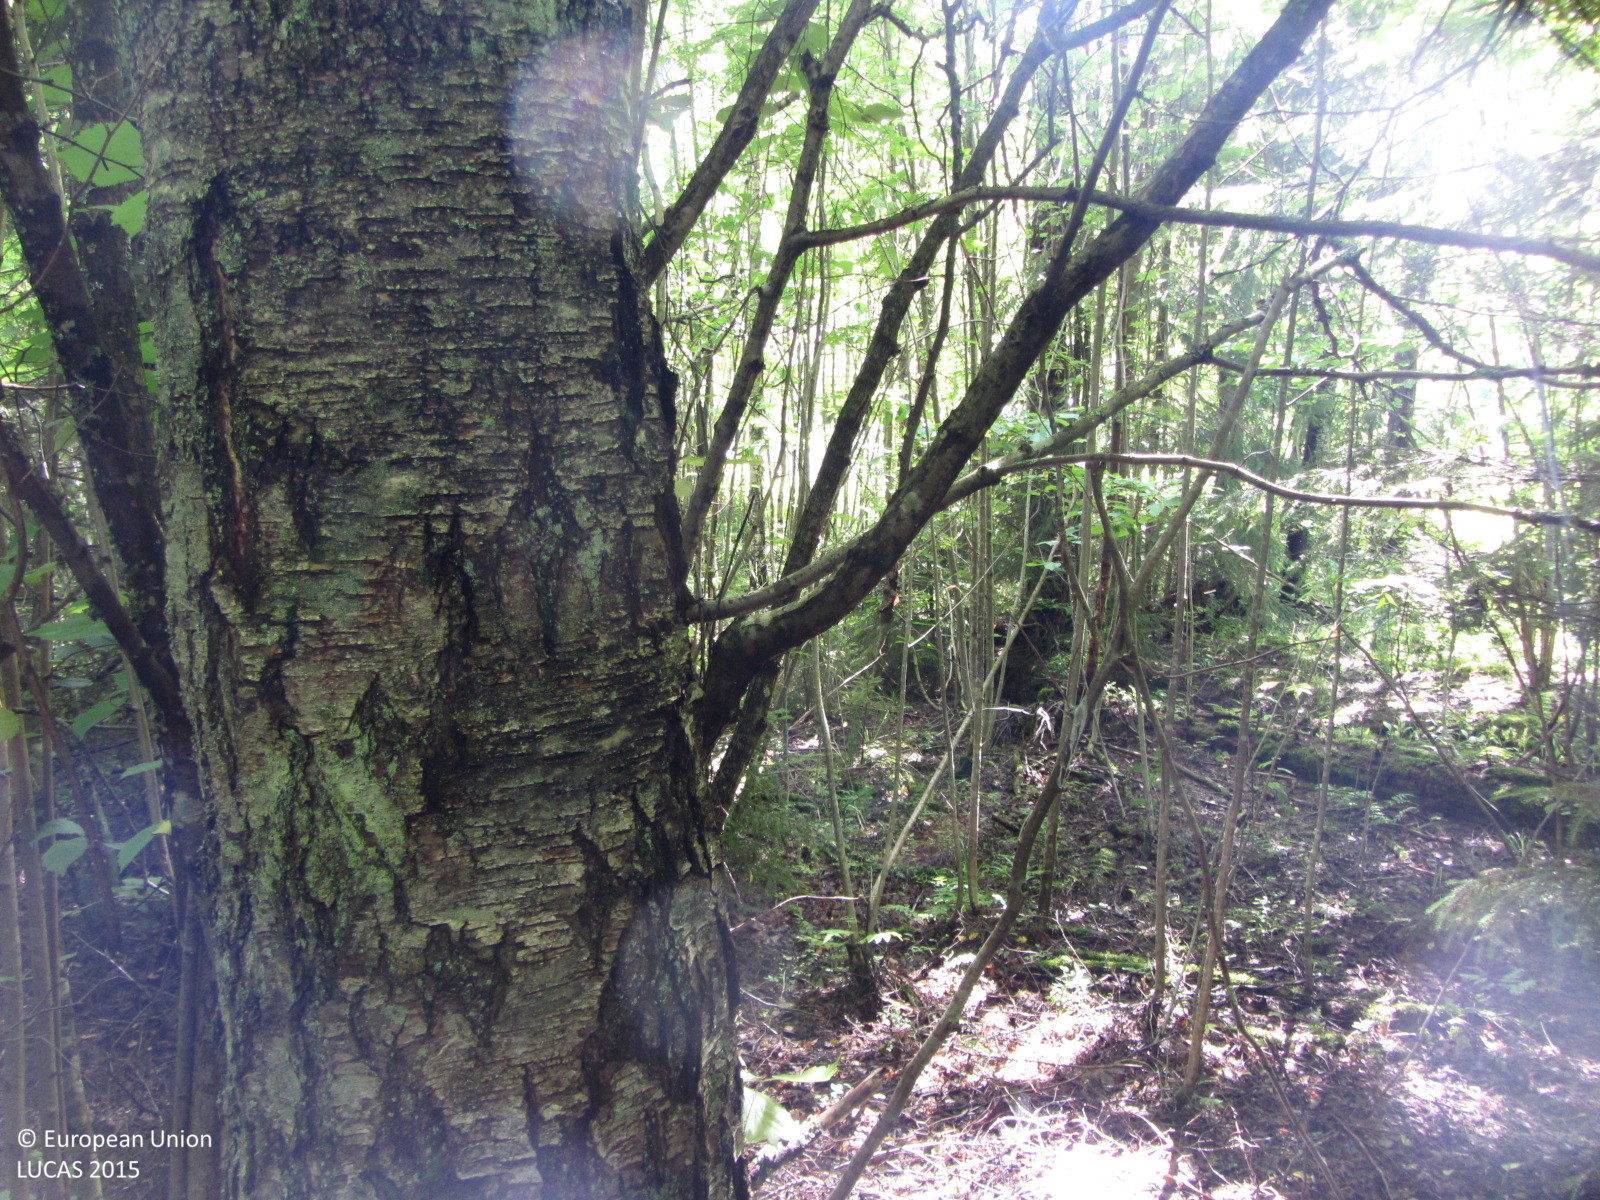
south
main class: Woodland
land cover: Spruce dominated mixed woodland
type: hemiboreal forest and nemoral coniferous forest and mixed broadleaved-coniferous forest
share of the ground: > 75 %
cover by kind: broadleaved forest trees 55 %, coniferous forest trees 35 %, herbaceous plants 10 %
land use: Forestry
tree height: > 5 m
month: July
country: FI
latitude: 60.1841
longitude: 24.4415
